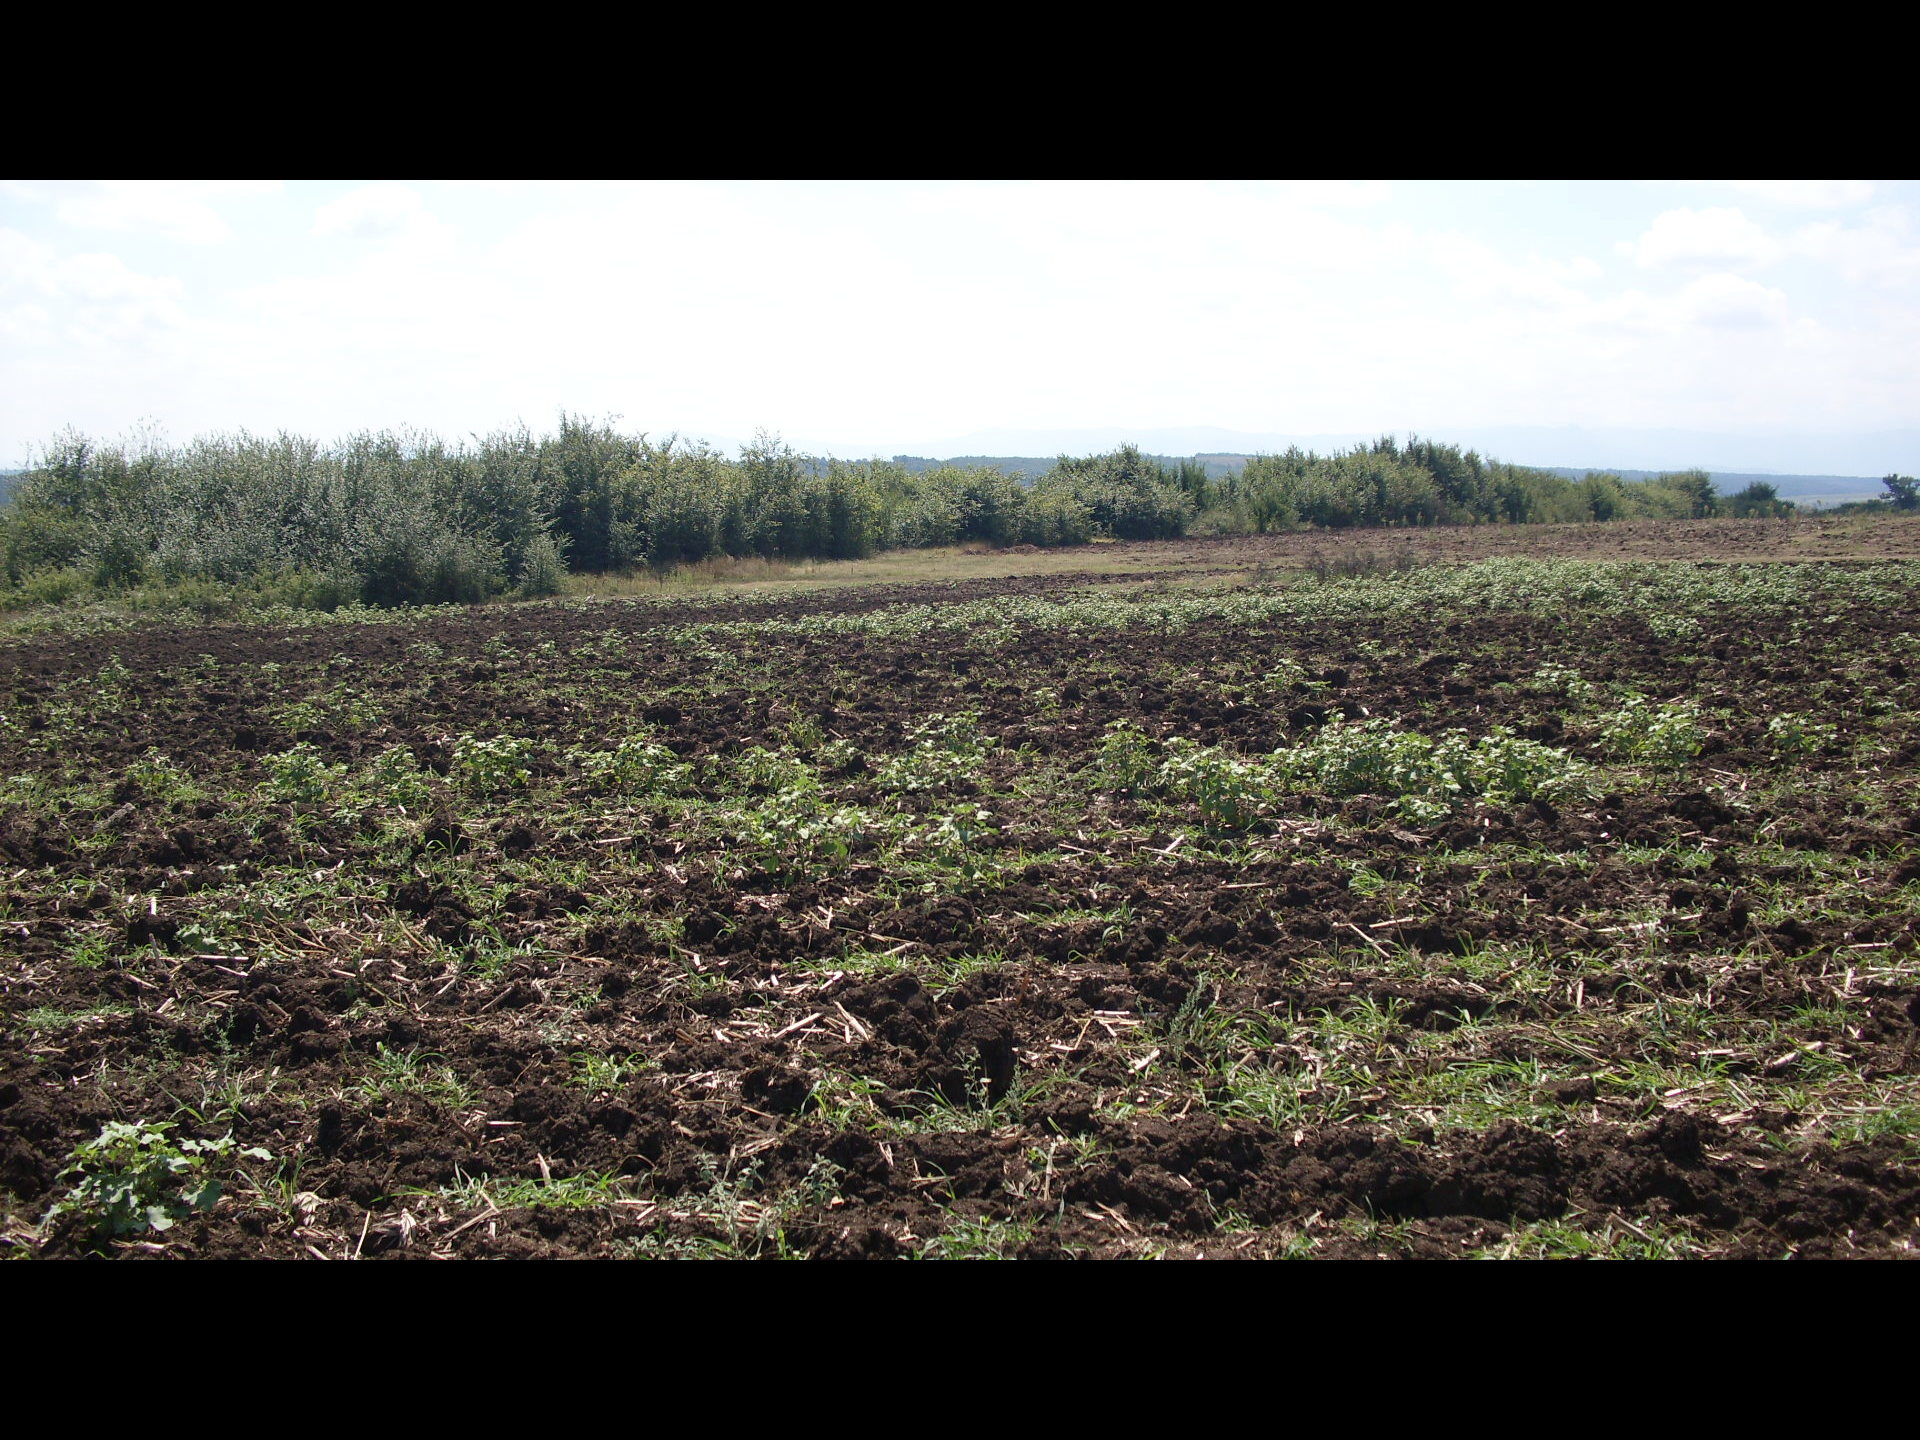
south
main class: Cropland
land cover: Maize
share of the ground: < 10 %
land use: Agriculture (excluding fallow land and kitchen gardens)
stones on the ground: < 10 %
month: August
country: BG
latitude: 43.6748
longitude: 23.0002
